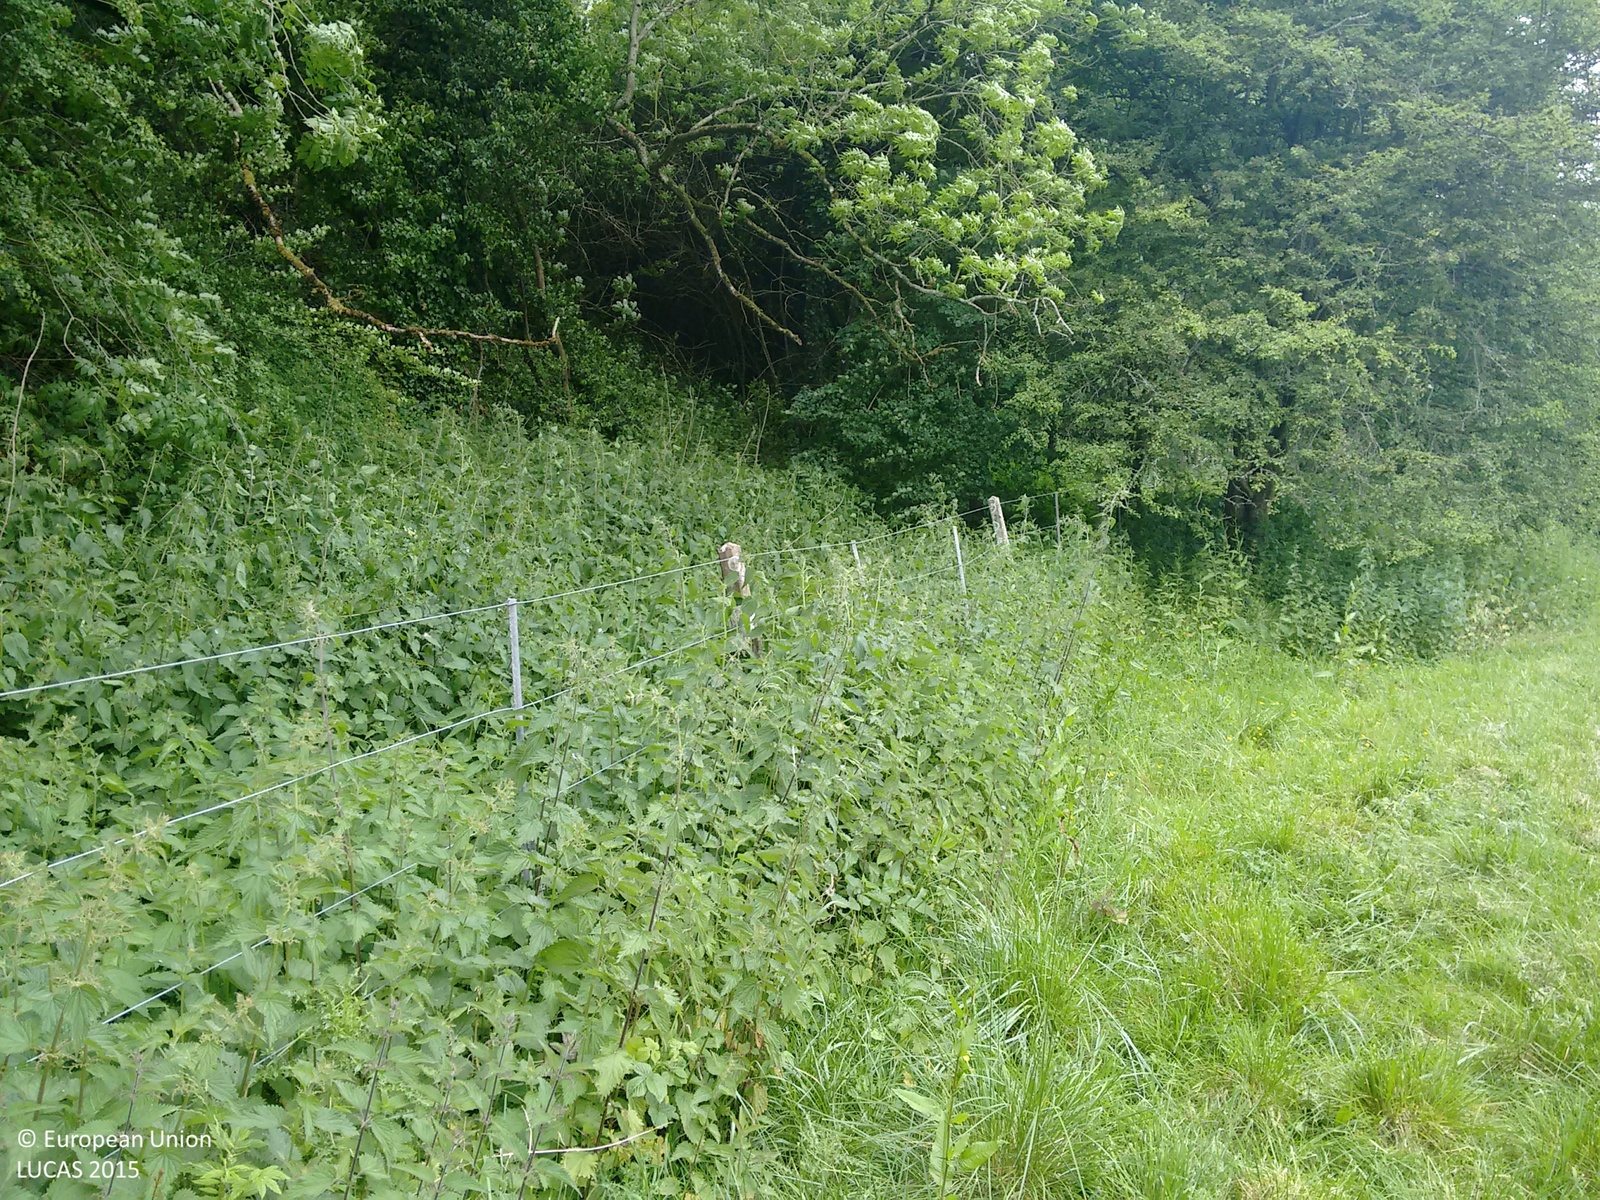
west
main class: Grassland
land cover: Grassland without tree/shrub cover
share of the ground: > 75 %
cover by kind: herbaceous plants 100 %
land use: Agriculture (excluding fallow land and kitchen gardens)
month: June
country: GB
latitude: 51.0893
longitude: -1.8636
